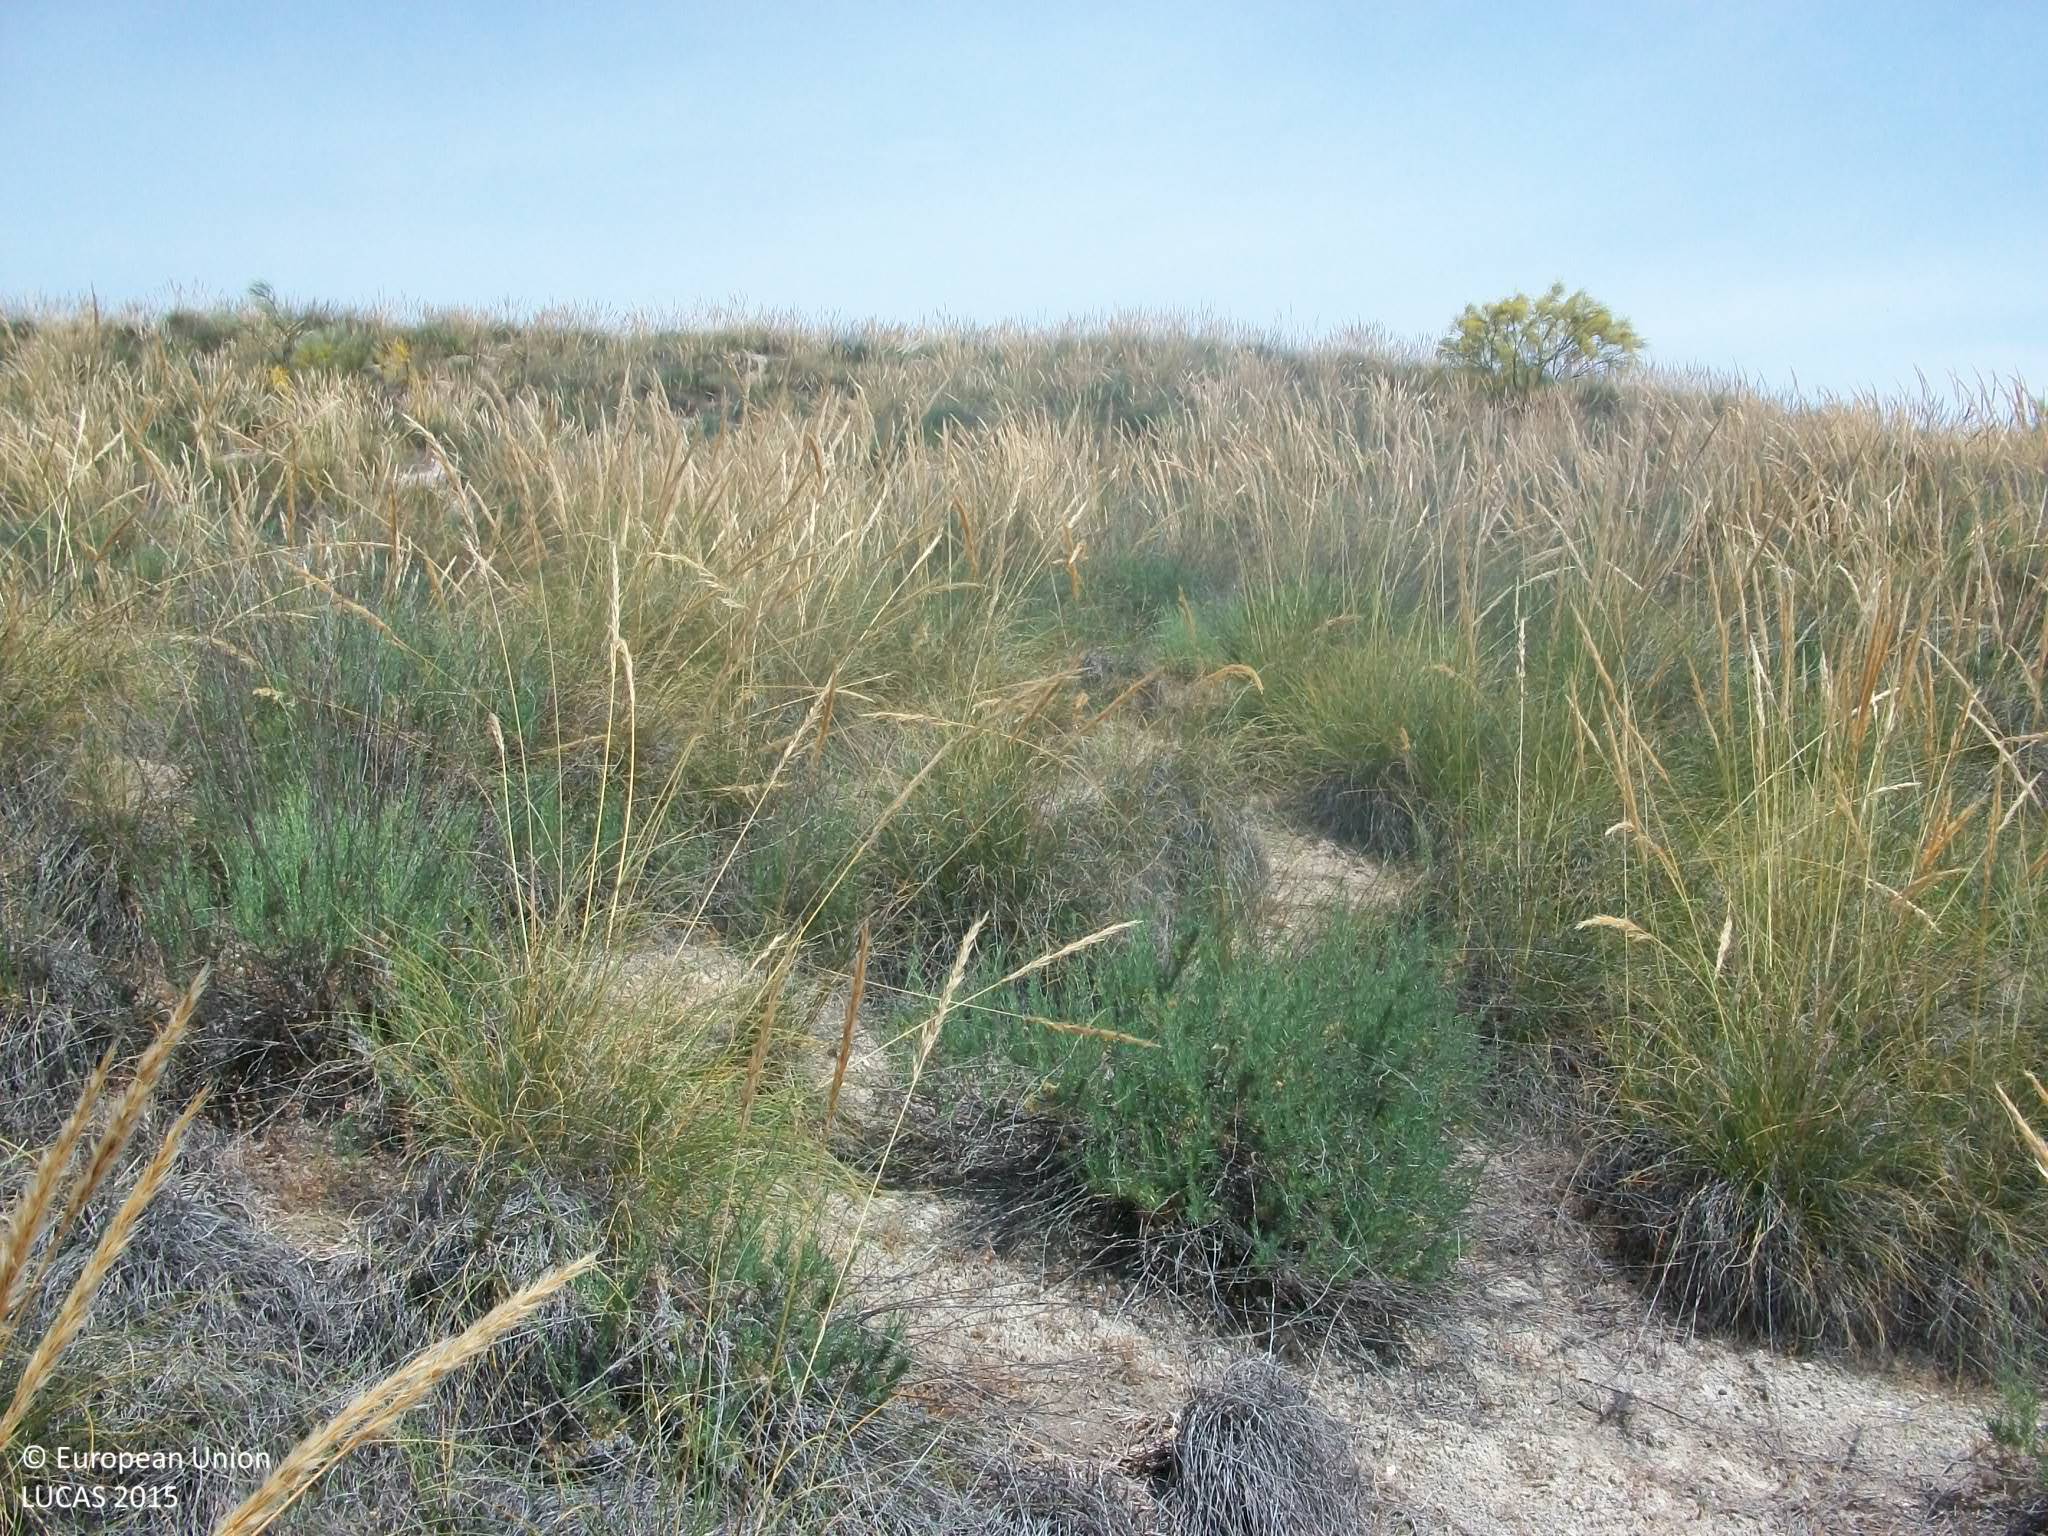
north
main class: Shrubland
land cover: Shrubland without tree cover
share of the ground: > 75 %
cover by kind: shrubs 90 %, consolidated bare surface 10 %
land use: Semi-natural and natural areas not in use
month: May
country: ES
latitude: 40.0329
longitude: -3.7085
